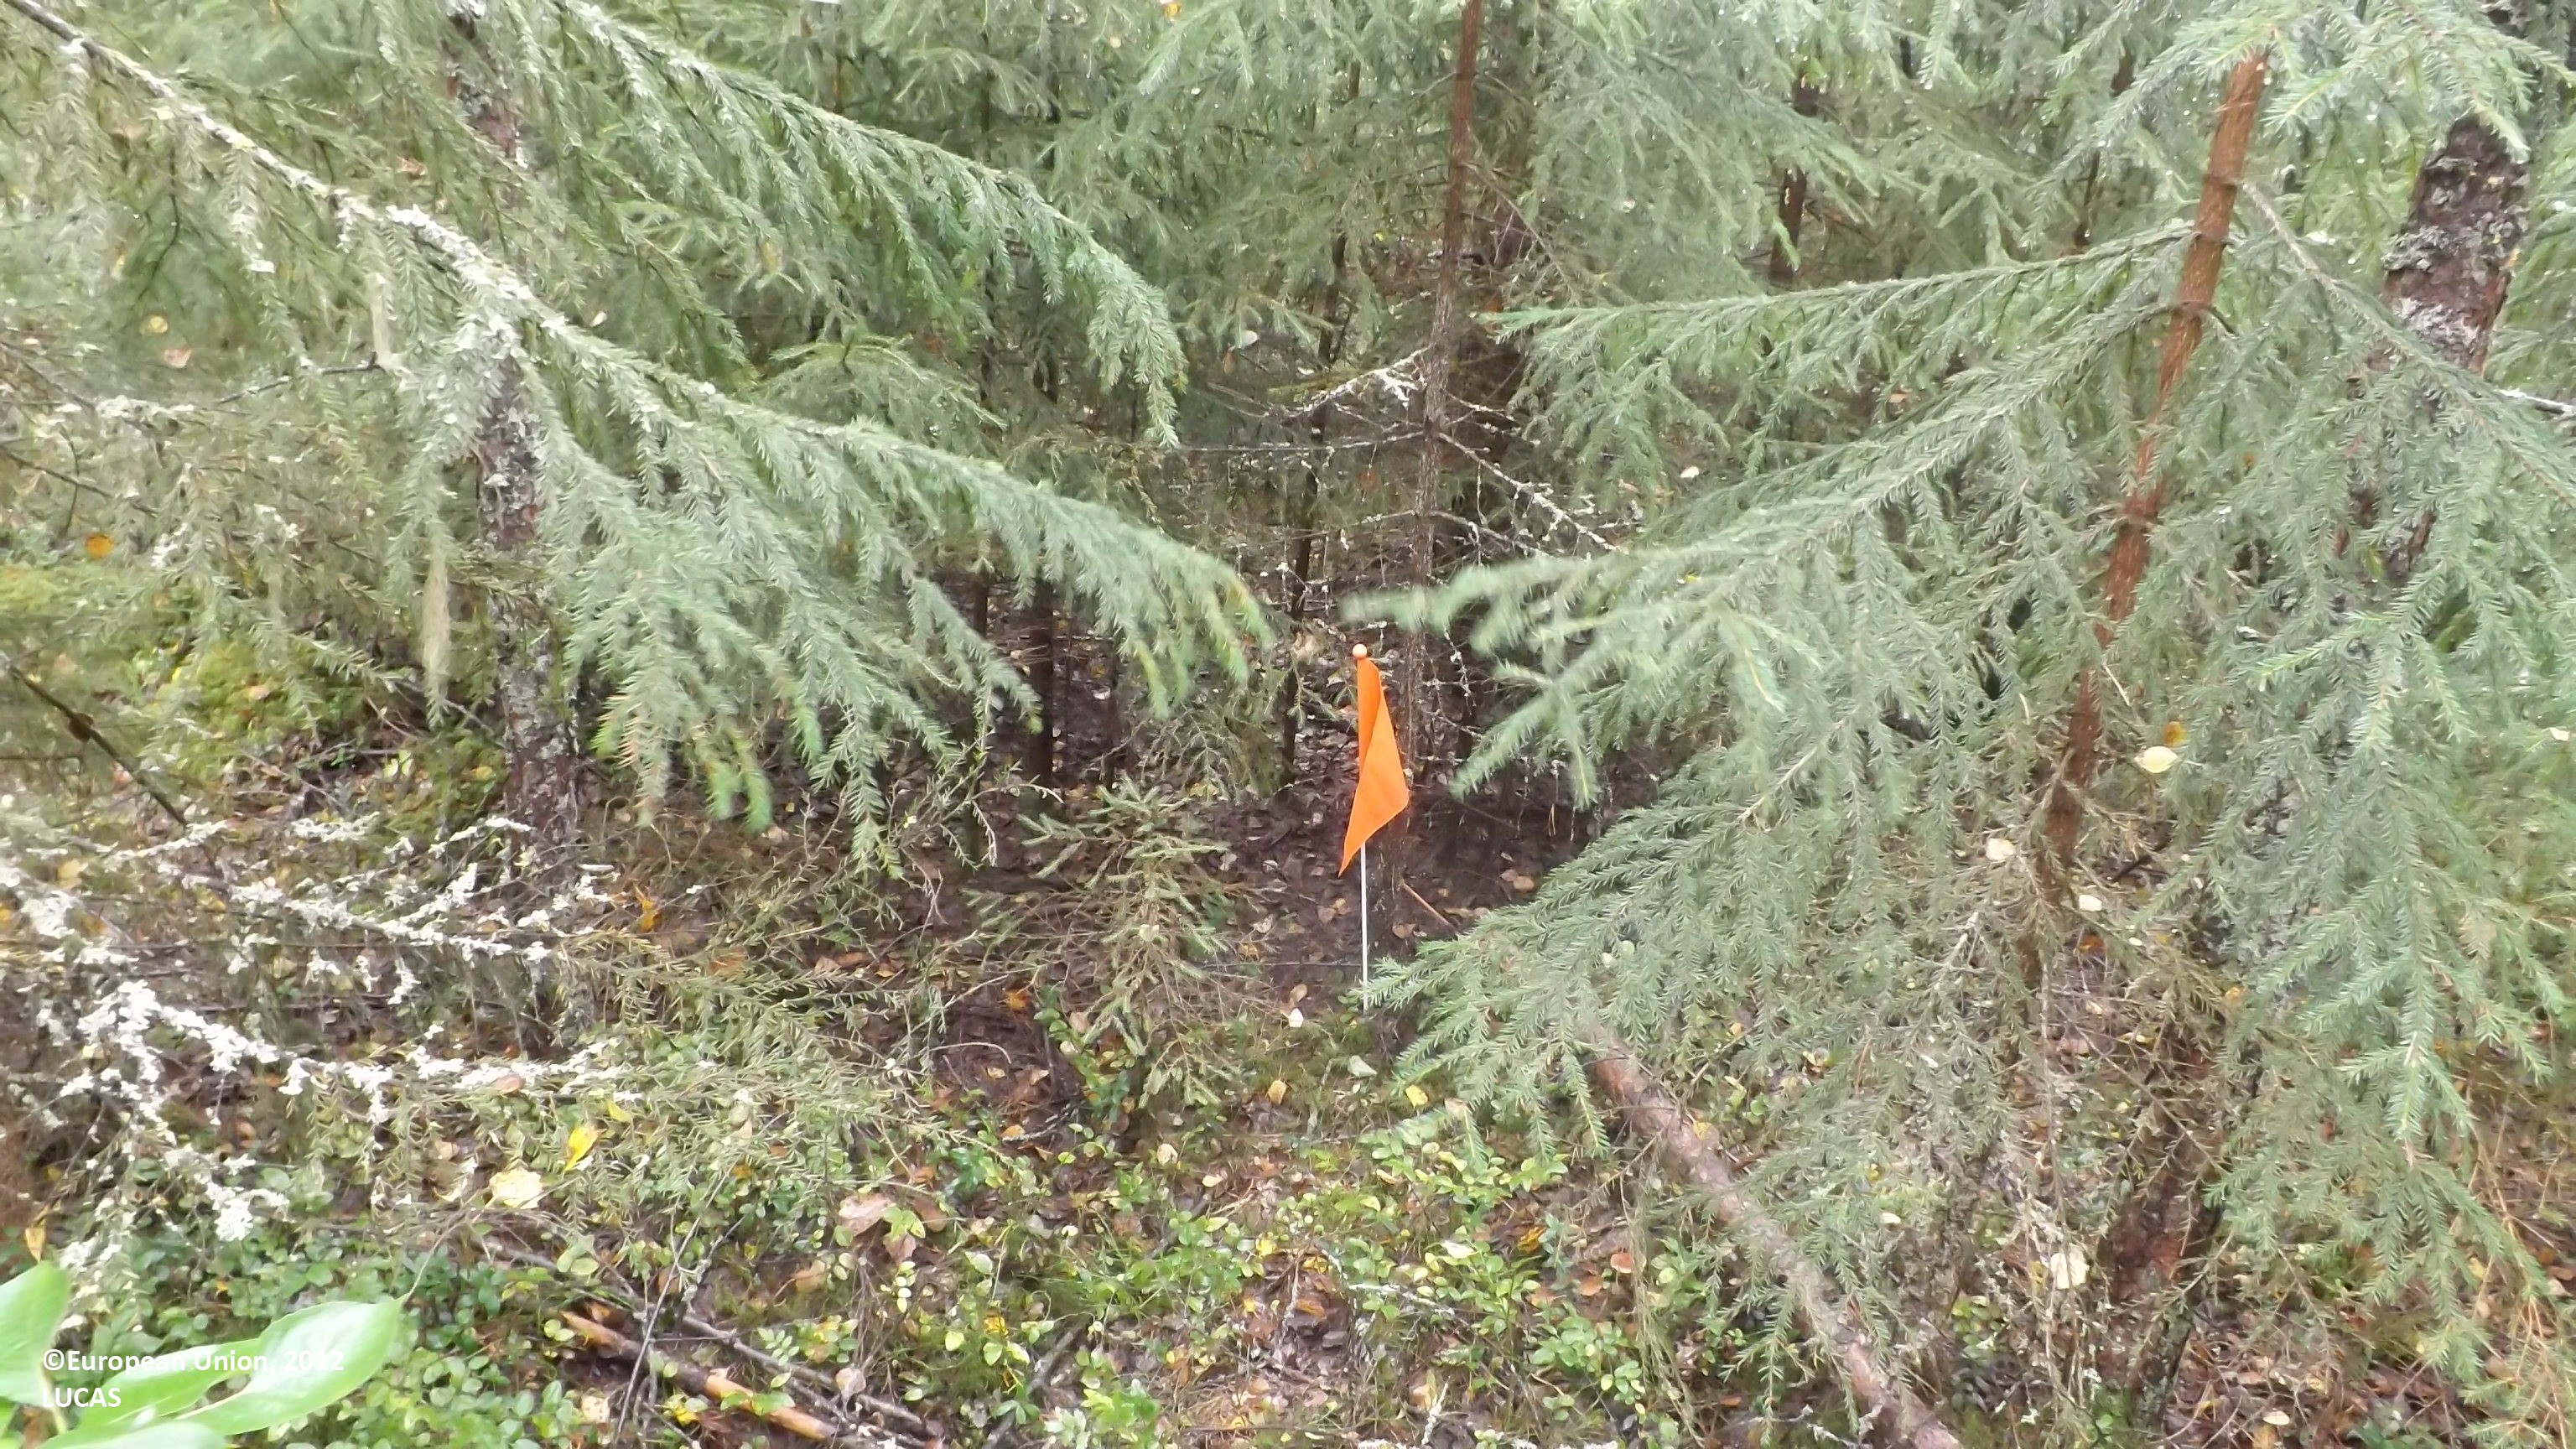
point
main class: Woodland
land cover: Other mixed woodland
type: boreal forest
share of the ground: > 75 %
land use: Forestry
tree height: > 5 m
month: August
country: FI
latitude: 63.8932
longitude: 23.4804
